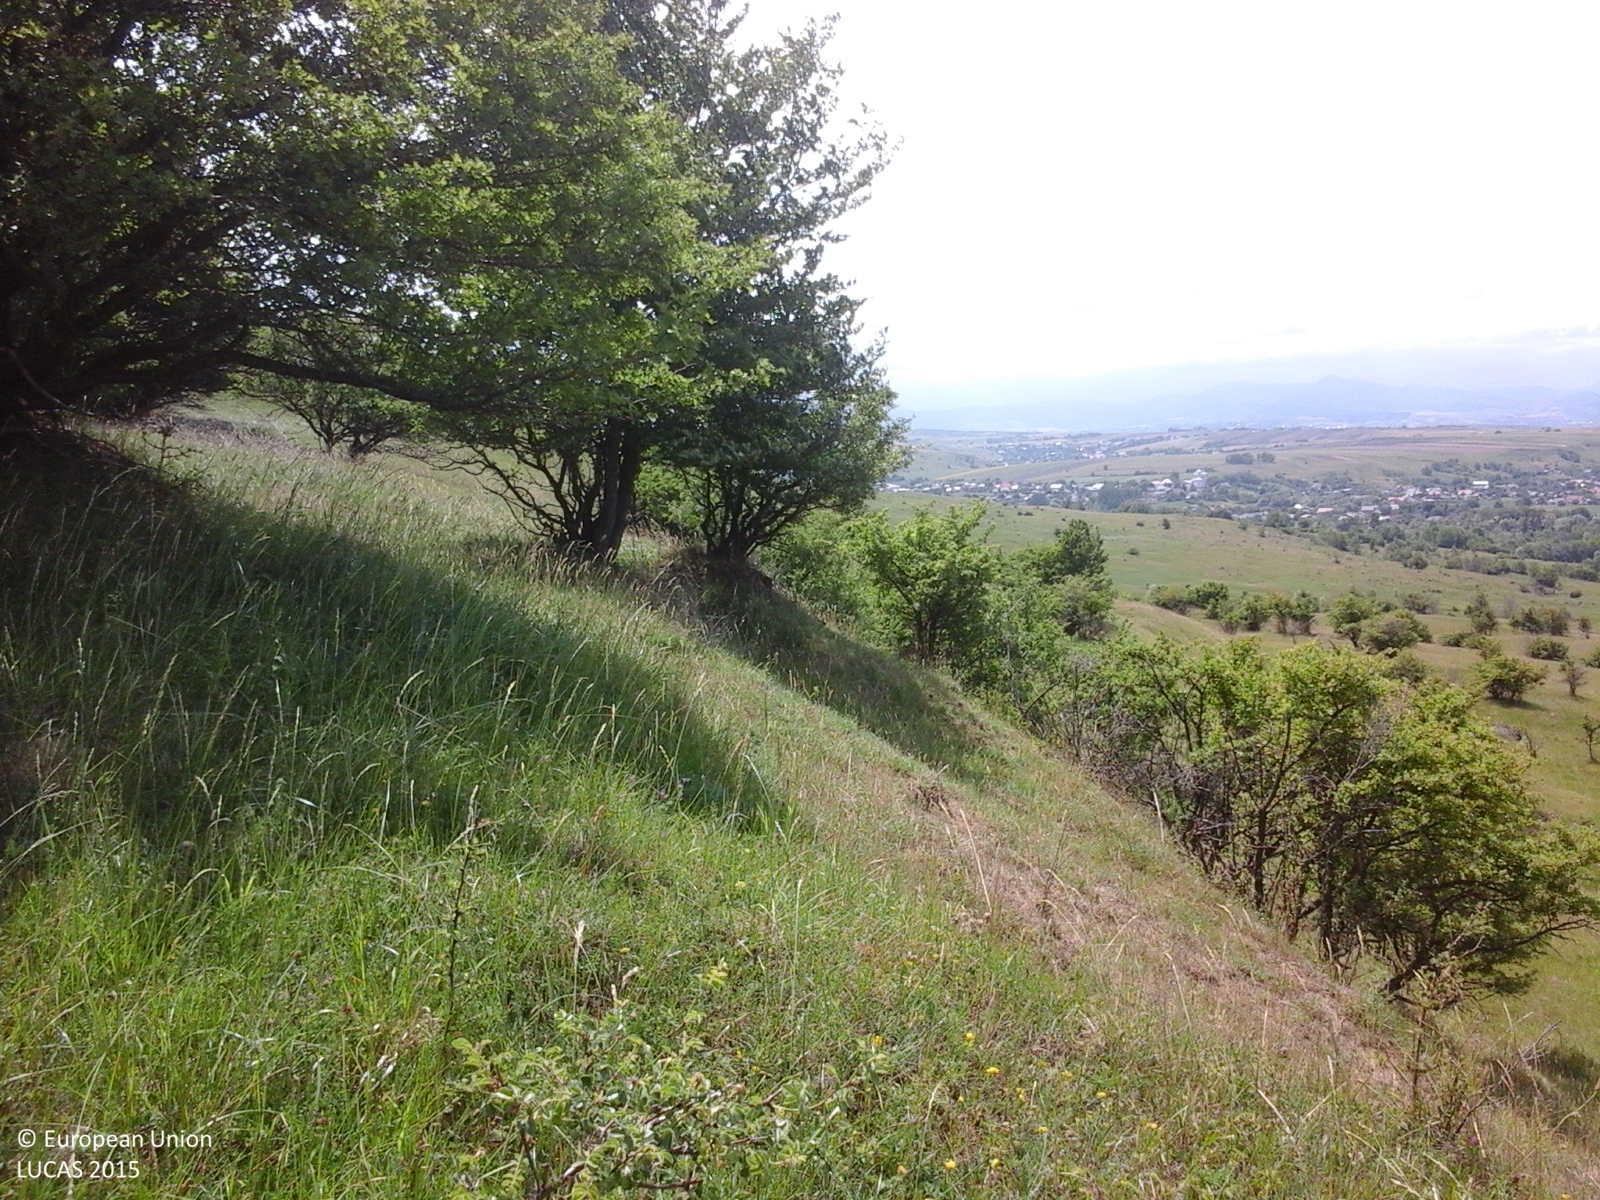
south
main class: Grassland
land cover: Grassland with sparse tree/shrub cover
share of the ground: > 75 %
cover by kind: herbaceous plants 85 %, shrubs 10 %, broadleaved forest trees 5 %
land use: Agriculture (excluding fallow land and kitchen gardens)
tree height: > 5 m
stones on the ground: < 10 %
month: June
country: RO
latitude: 47.1594
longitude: 26.4546
